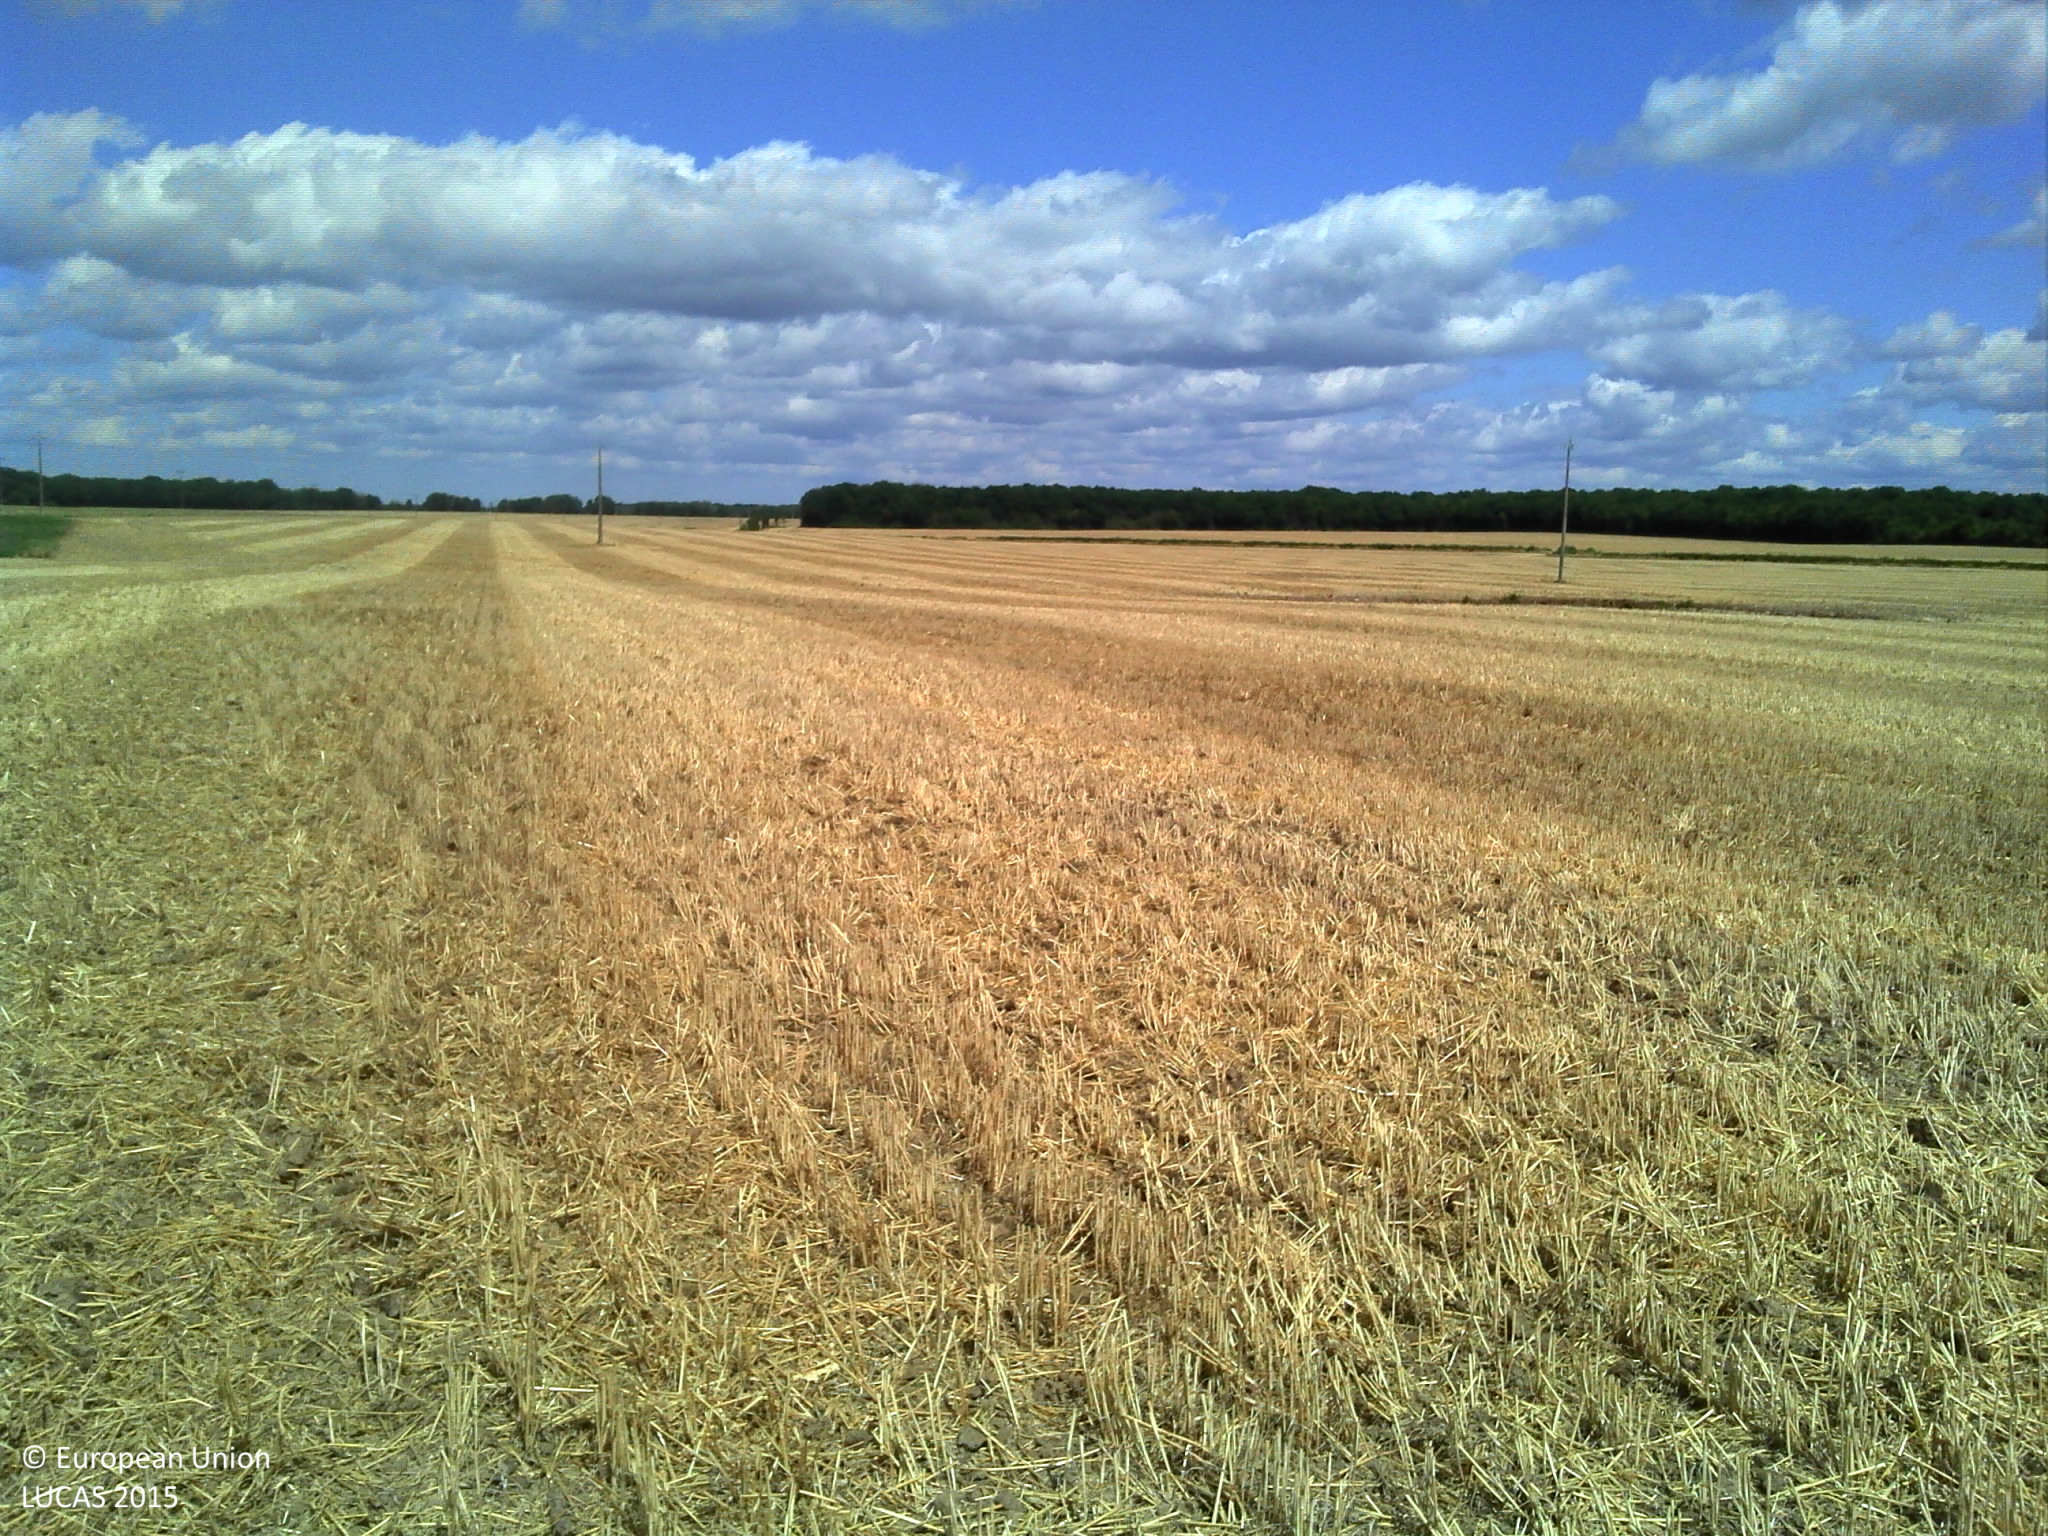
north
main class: Cropland
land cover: Common wheat
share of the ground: > 75 %
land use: Agriculture (excluding fallow land and kitchen gardens)
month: August
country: FR
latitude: 47.1436
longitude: 2.0922
